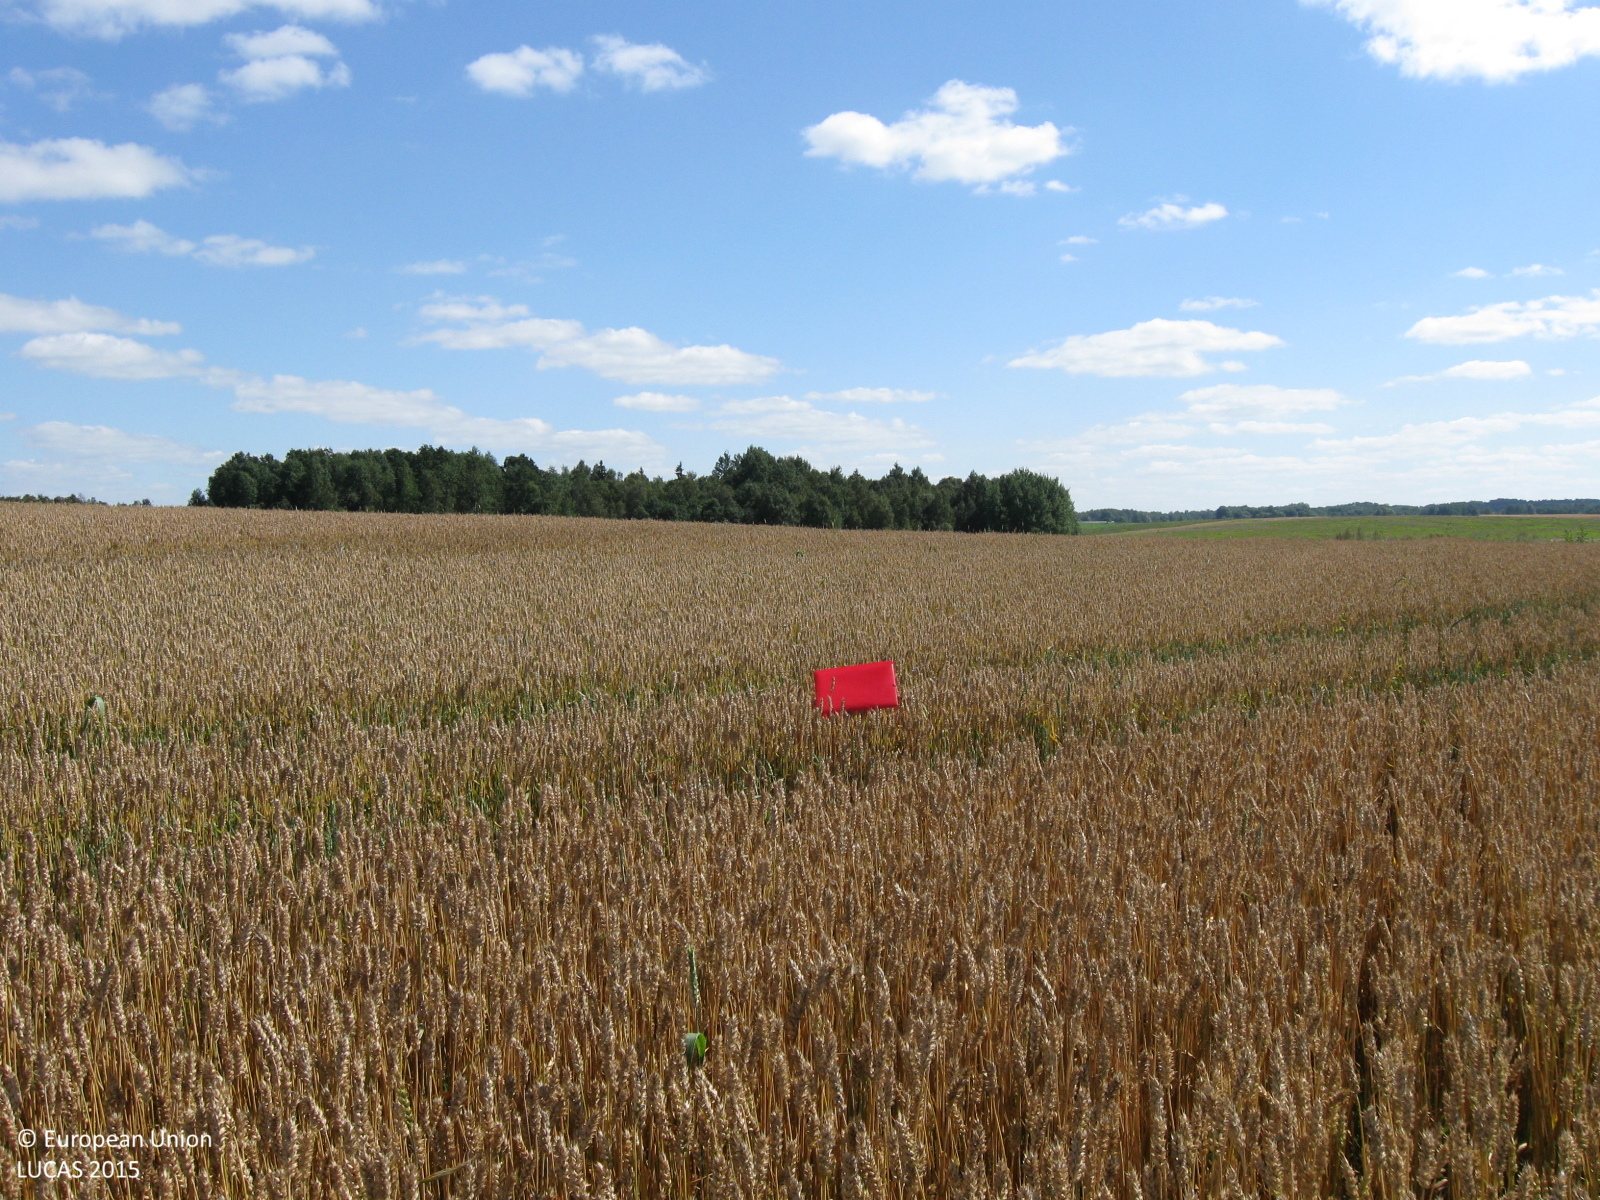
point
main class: Cropland
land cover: Common wheat
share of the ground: > 75 %
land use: Agriculture (excluding fallow land and kitchen gardens)
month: August
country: LT
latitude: 55.5215
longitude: 22.6558
